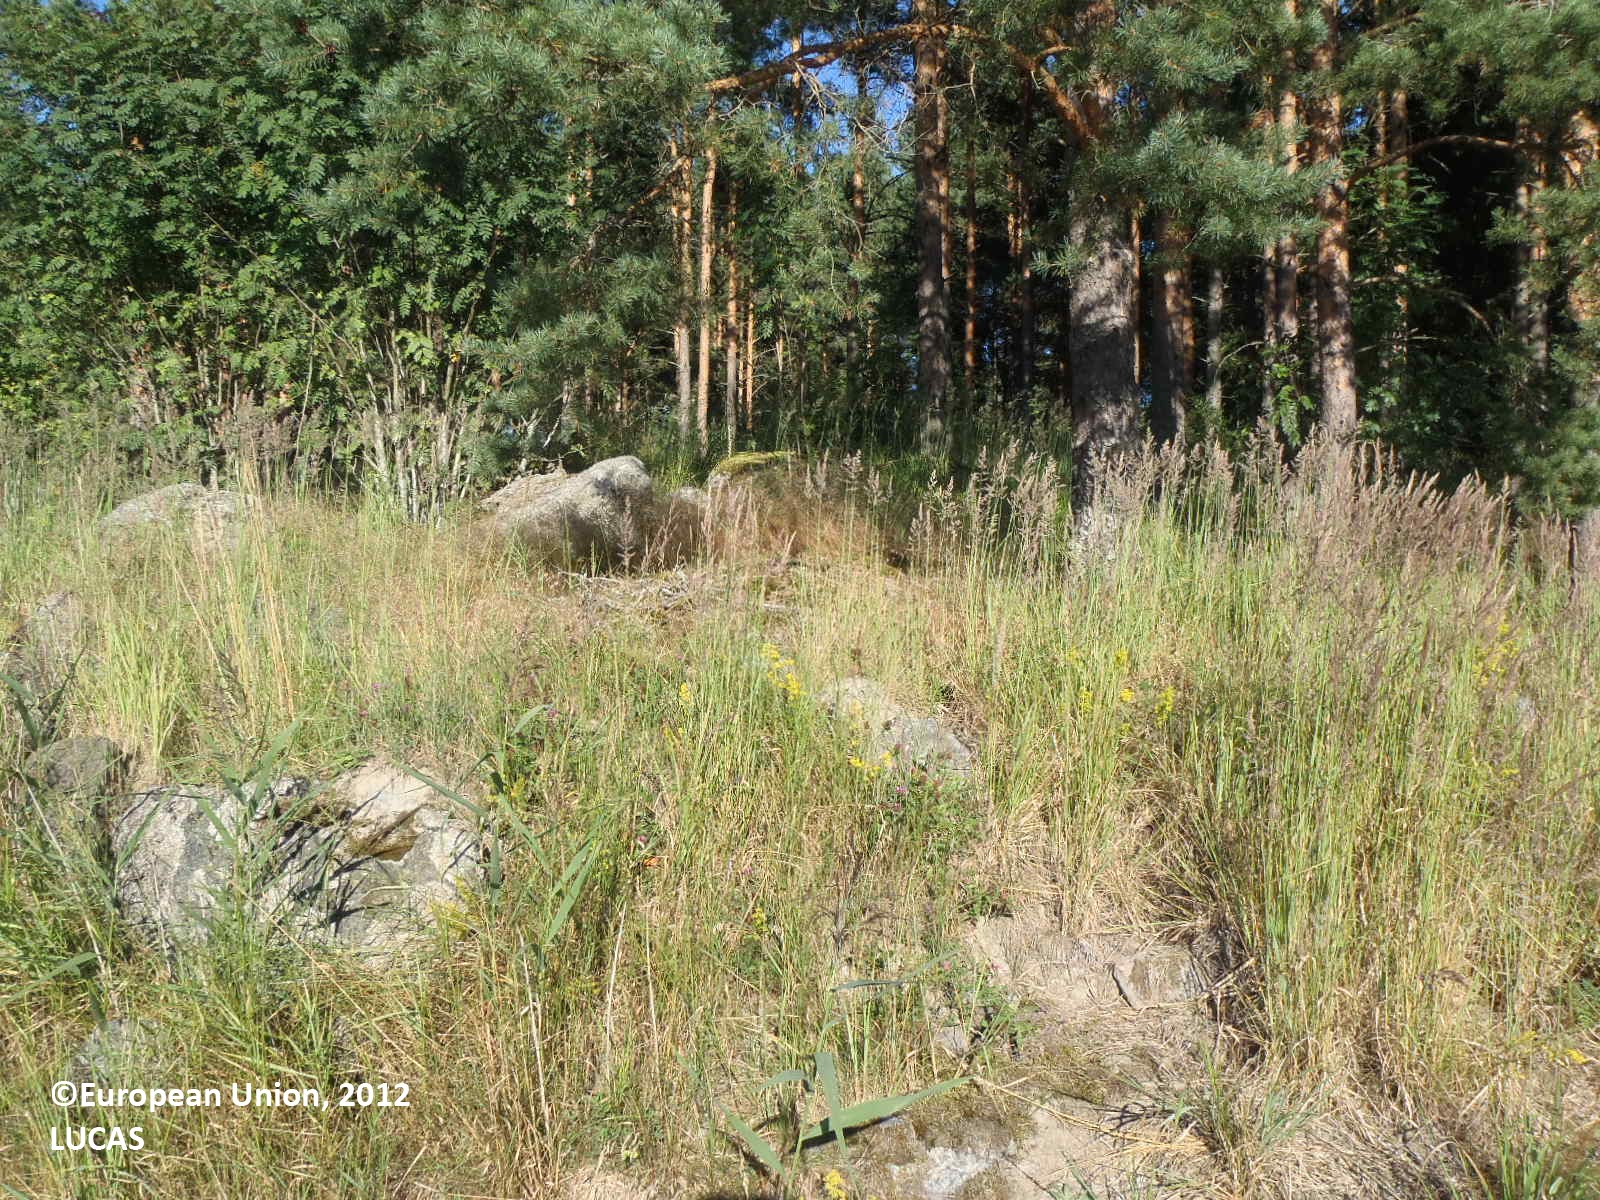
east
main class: Cropland
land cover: Mixed cereals for fodder
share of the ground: > 75 %
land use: Agriculture (excluding fallow land and kitchen gardens)
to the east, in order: Mixed cereals for fodder; Grass margins; Ditches and canals; Grass margins; Pine dominated mixed woodland; Grassland without tree/shrub cover; Pine dominated coniferous woodland; Grassland without tree/shrub cover; Barley
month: July
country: FI
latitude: 60.6038
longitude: 21.9146
